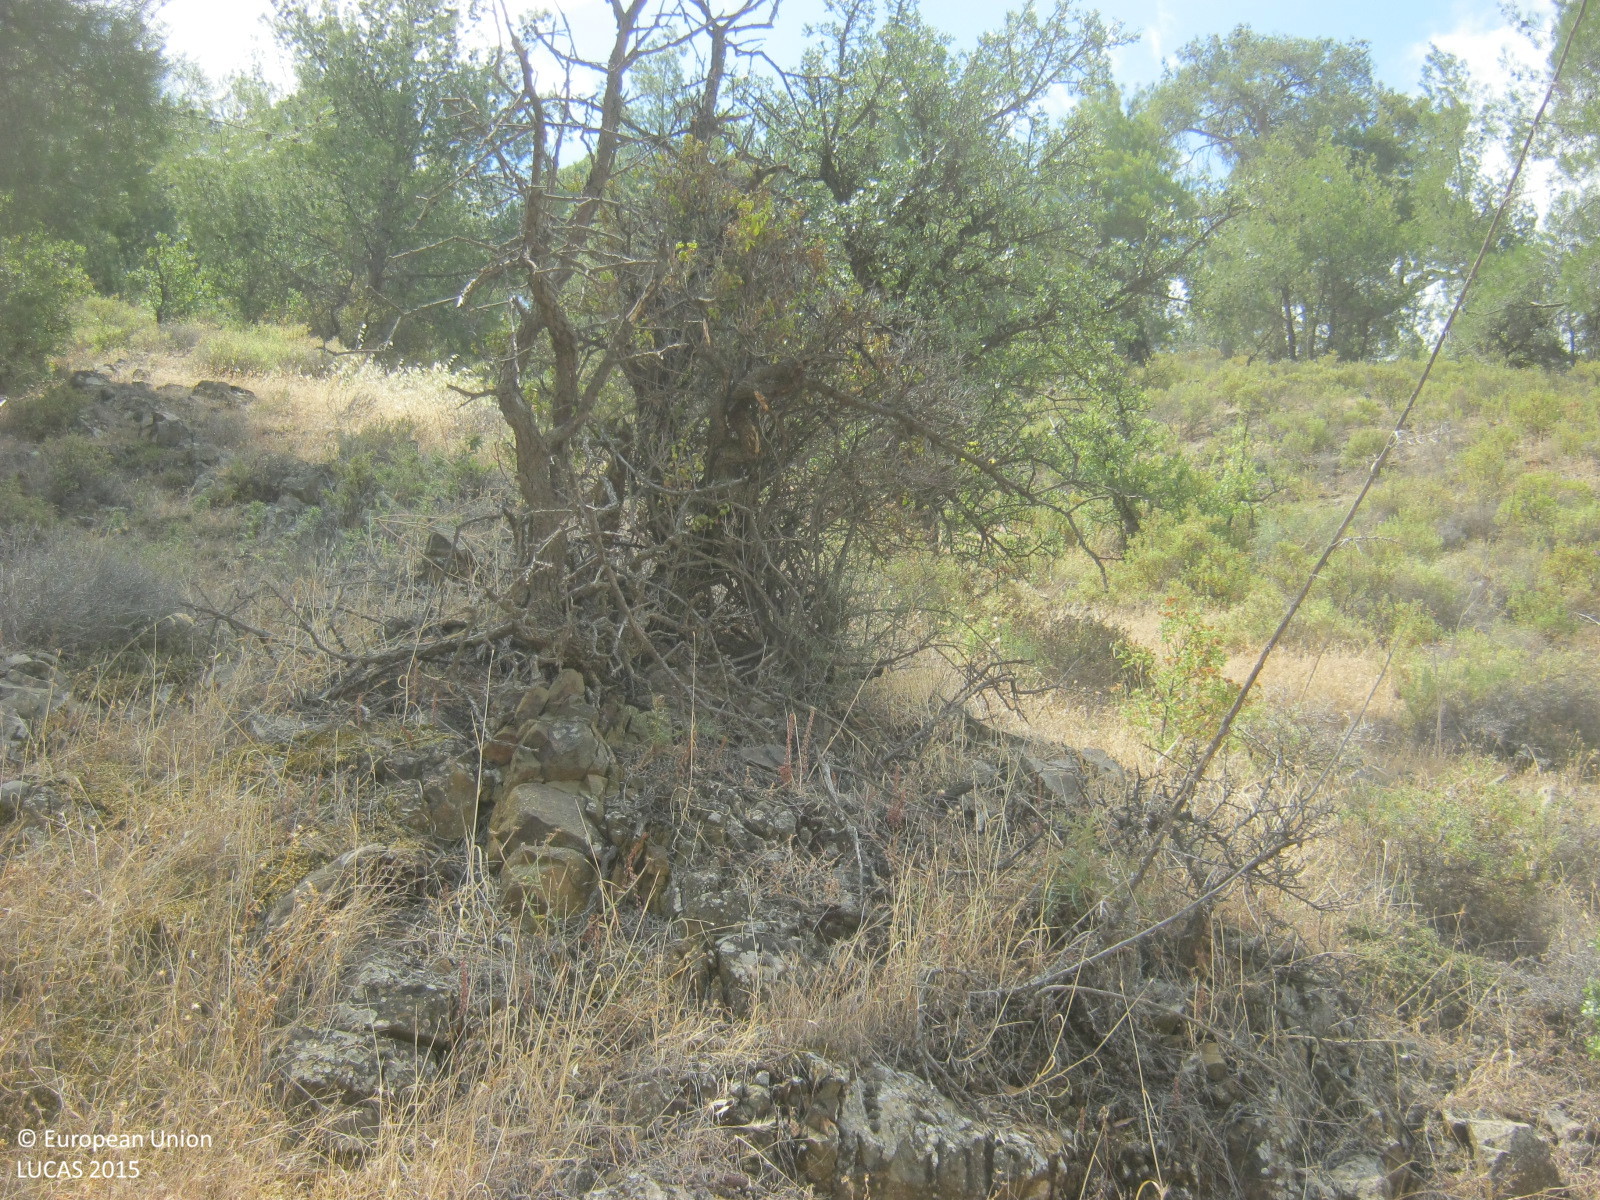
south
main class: Woodland
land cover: Pine dominated coniferous woodland
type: coniferous forest of the mediterranean region
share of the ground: 50 - 75 %
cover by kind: coniferous forest trees 50 %, shrubs 20 %, herbaceous plants 20 %, unconsolidated bare surface 10 %
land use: Forestry
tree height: > 5 m
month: June
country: CY
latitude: 35.0571
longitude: 32.9239
